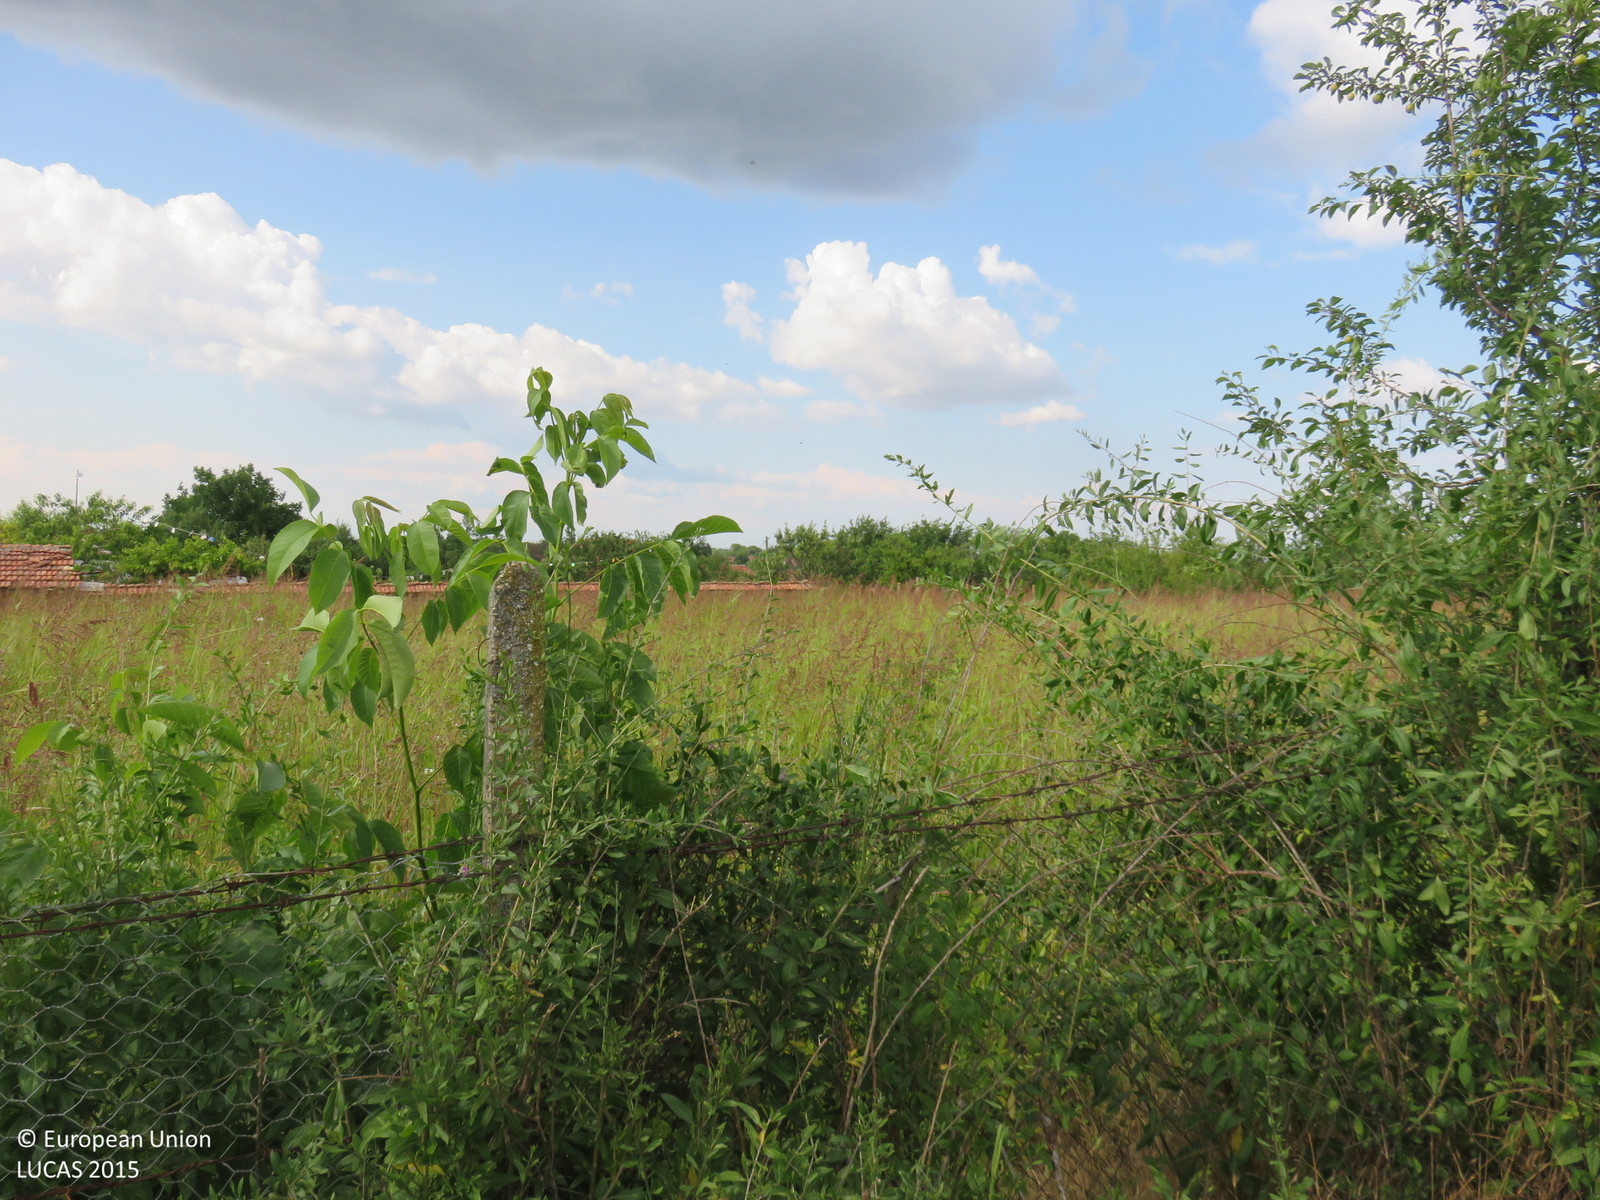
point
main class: Grassland
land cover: Grassland without tree/shrub cover
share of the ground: > 75 %
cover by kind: herbaceous plants 100 %
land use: Residential
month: June
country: BG
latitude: 43.3364
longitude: 24.9309
